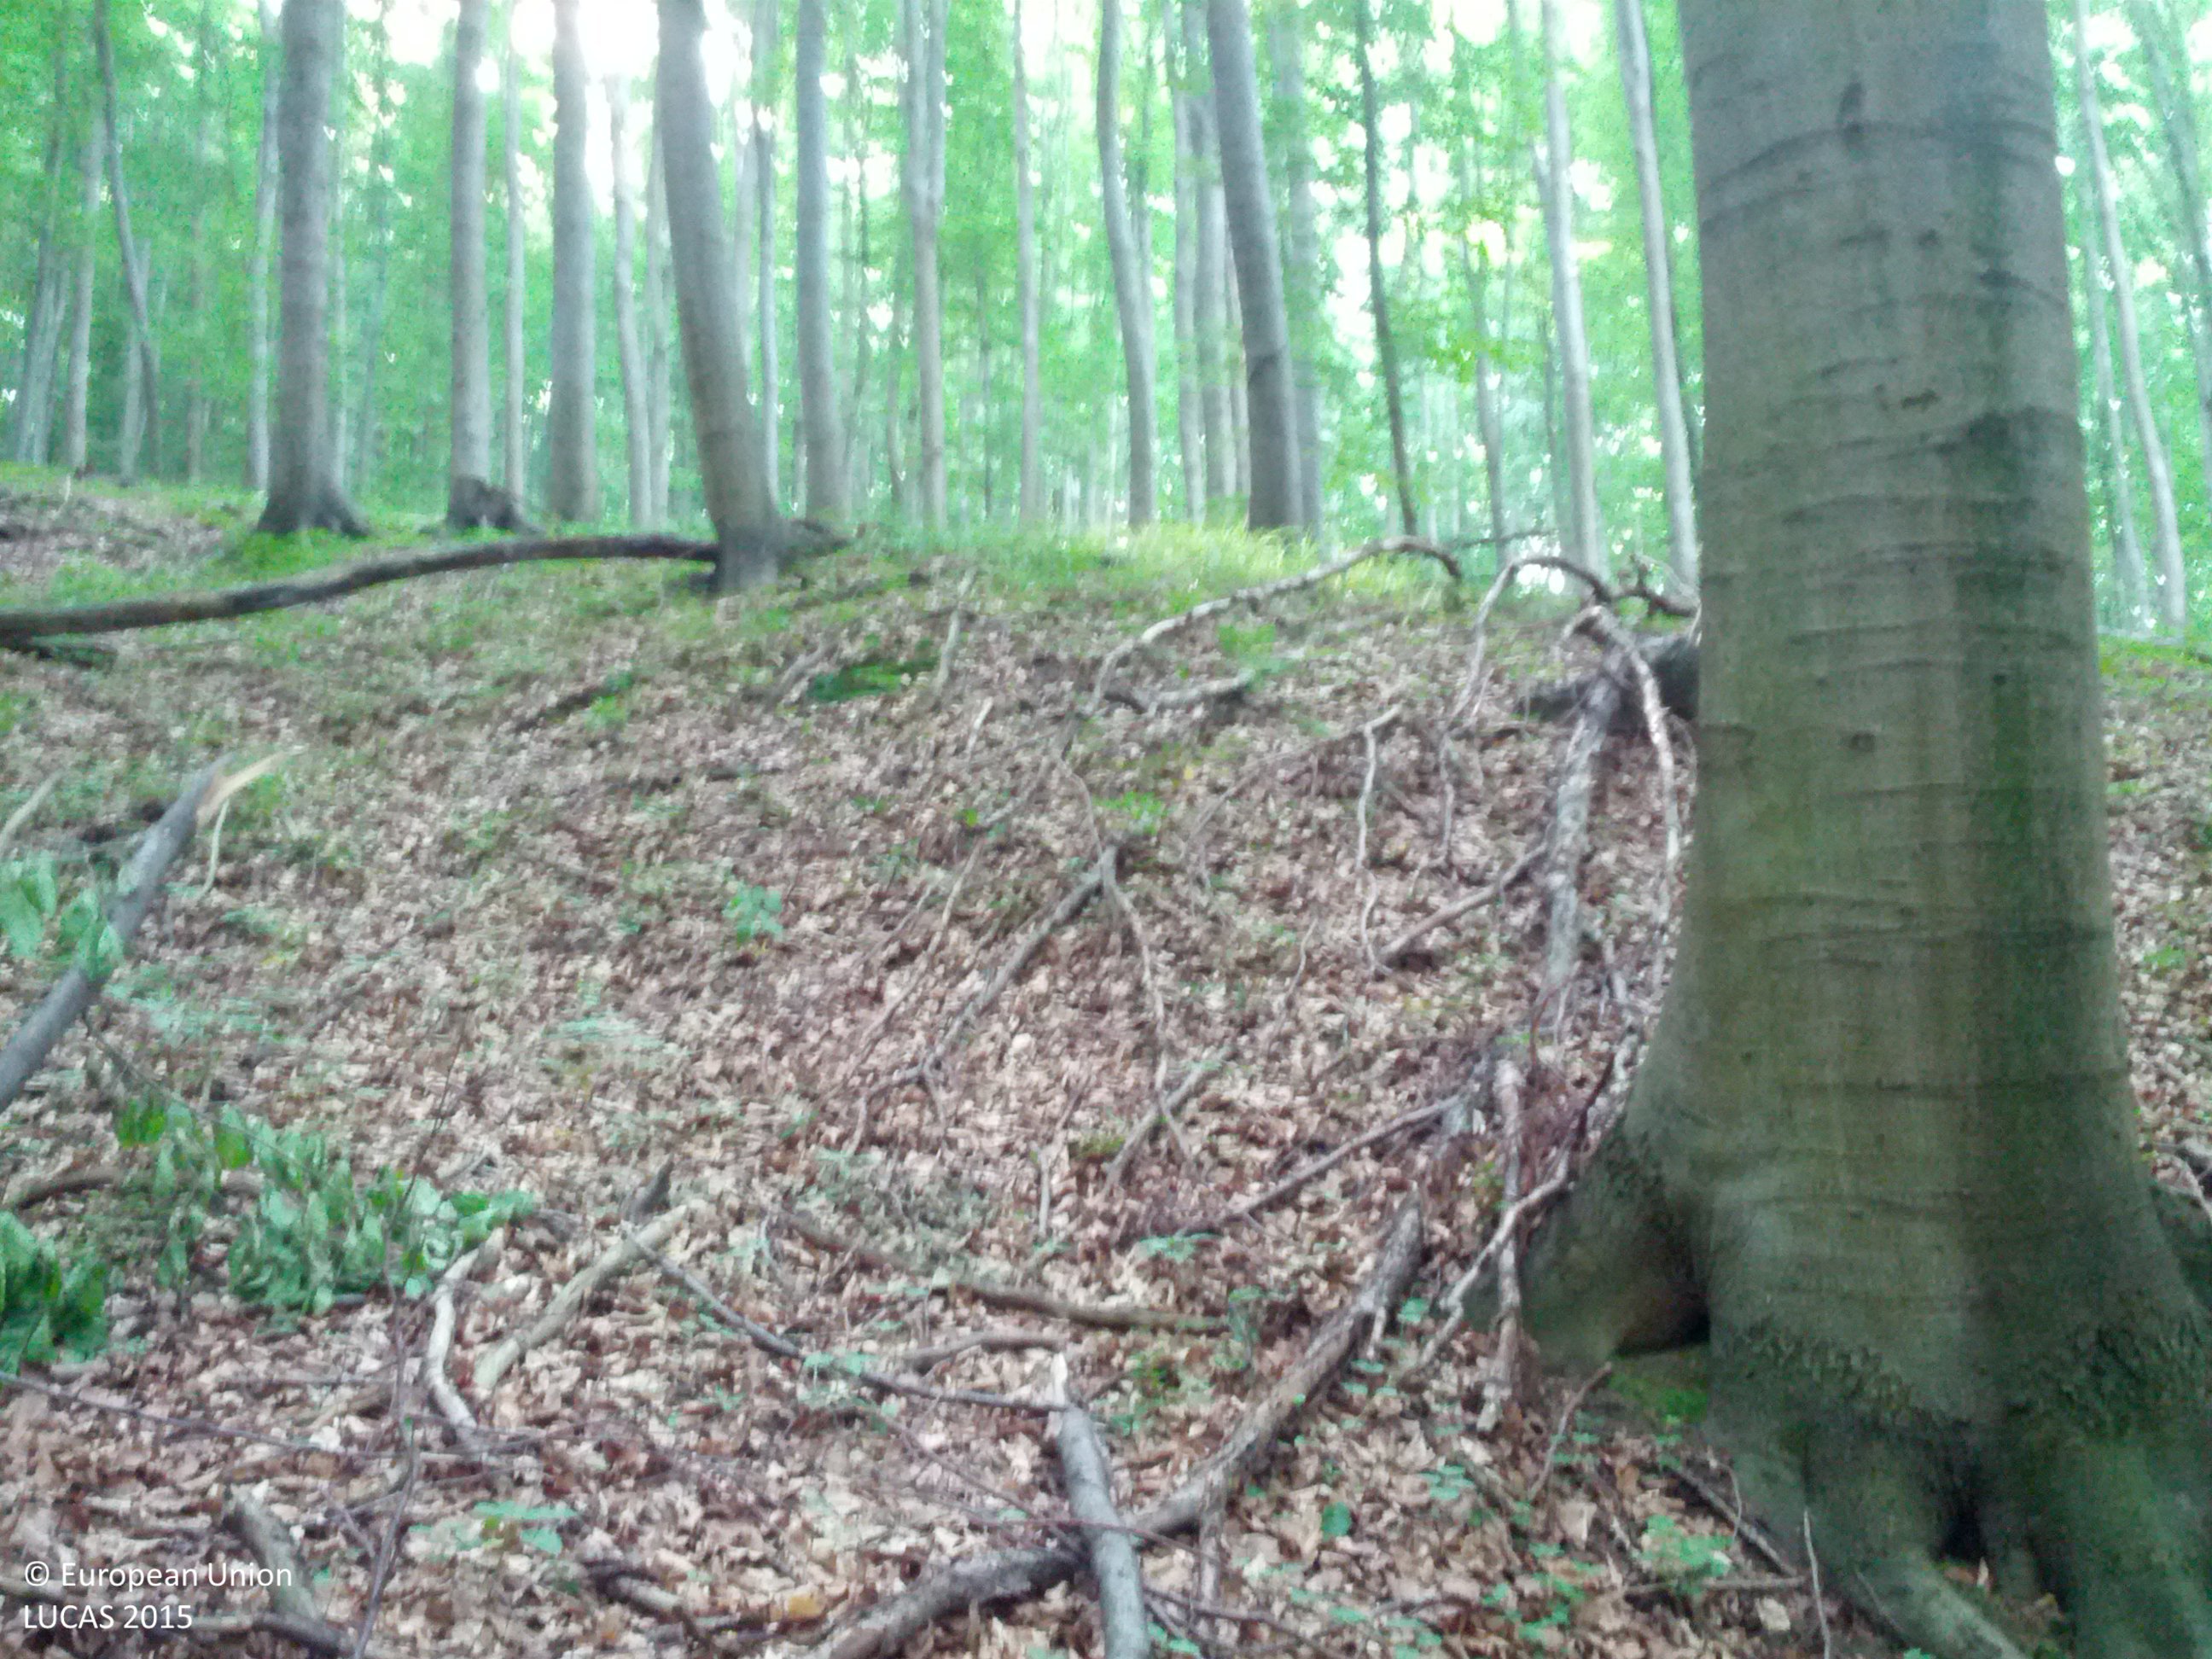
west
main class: Woodland
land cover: Broadleaved woodland
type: beech forest
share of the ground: > 75 %
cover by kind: broadleaved forest trees 95 %, herbaceous plants 5 %
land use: Forestry
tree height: > 5 m
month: May
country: AT
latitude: 48.2632
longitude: 16.2418
